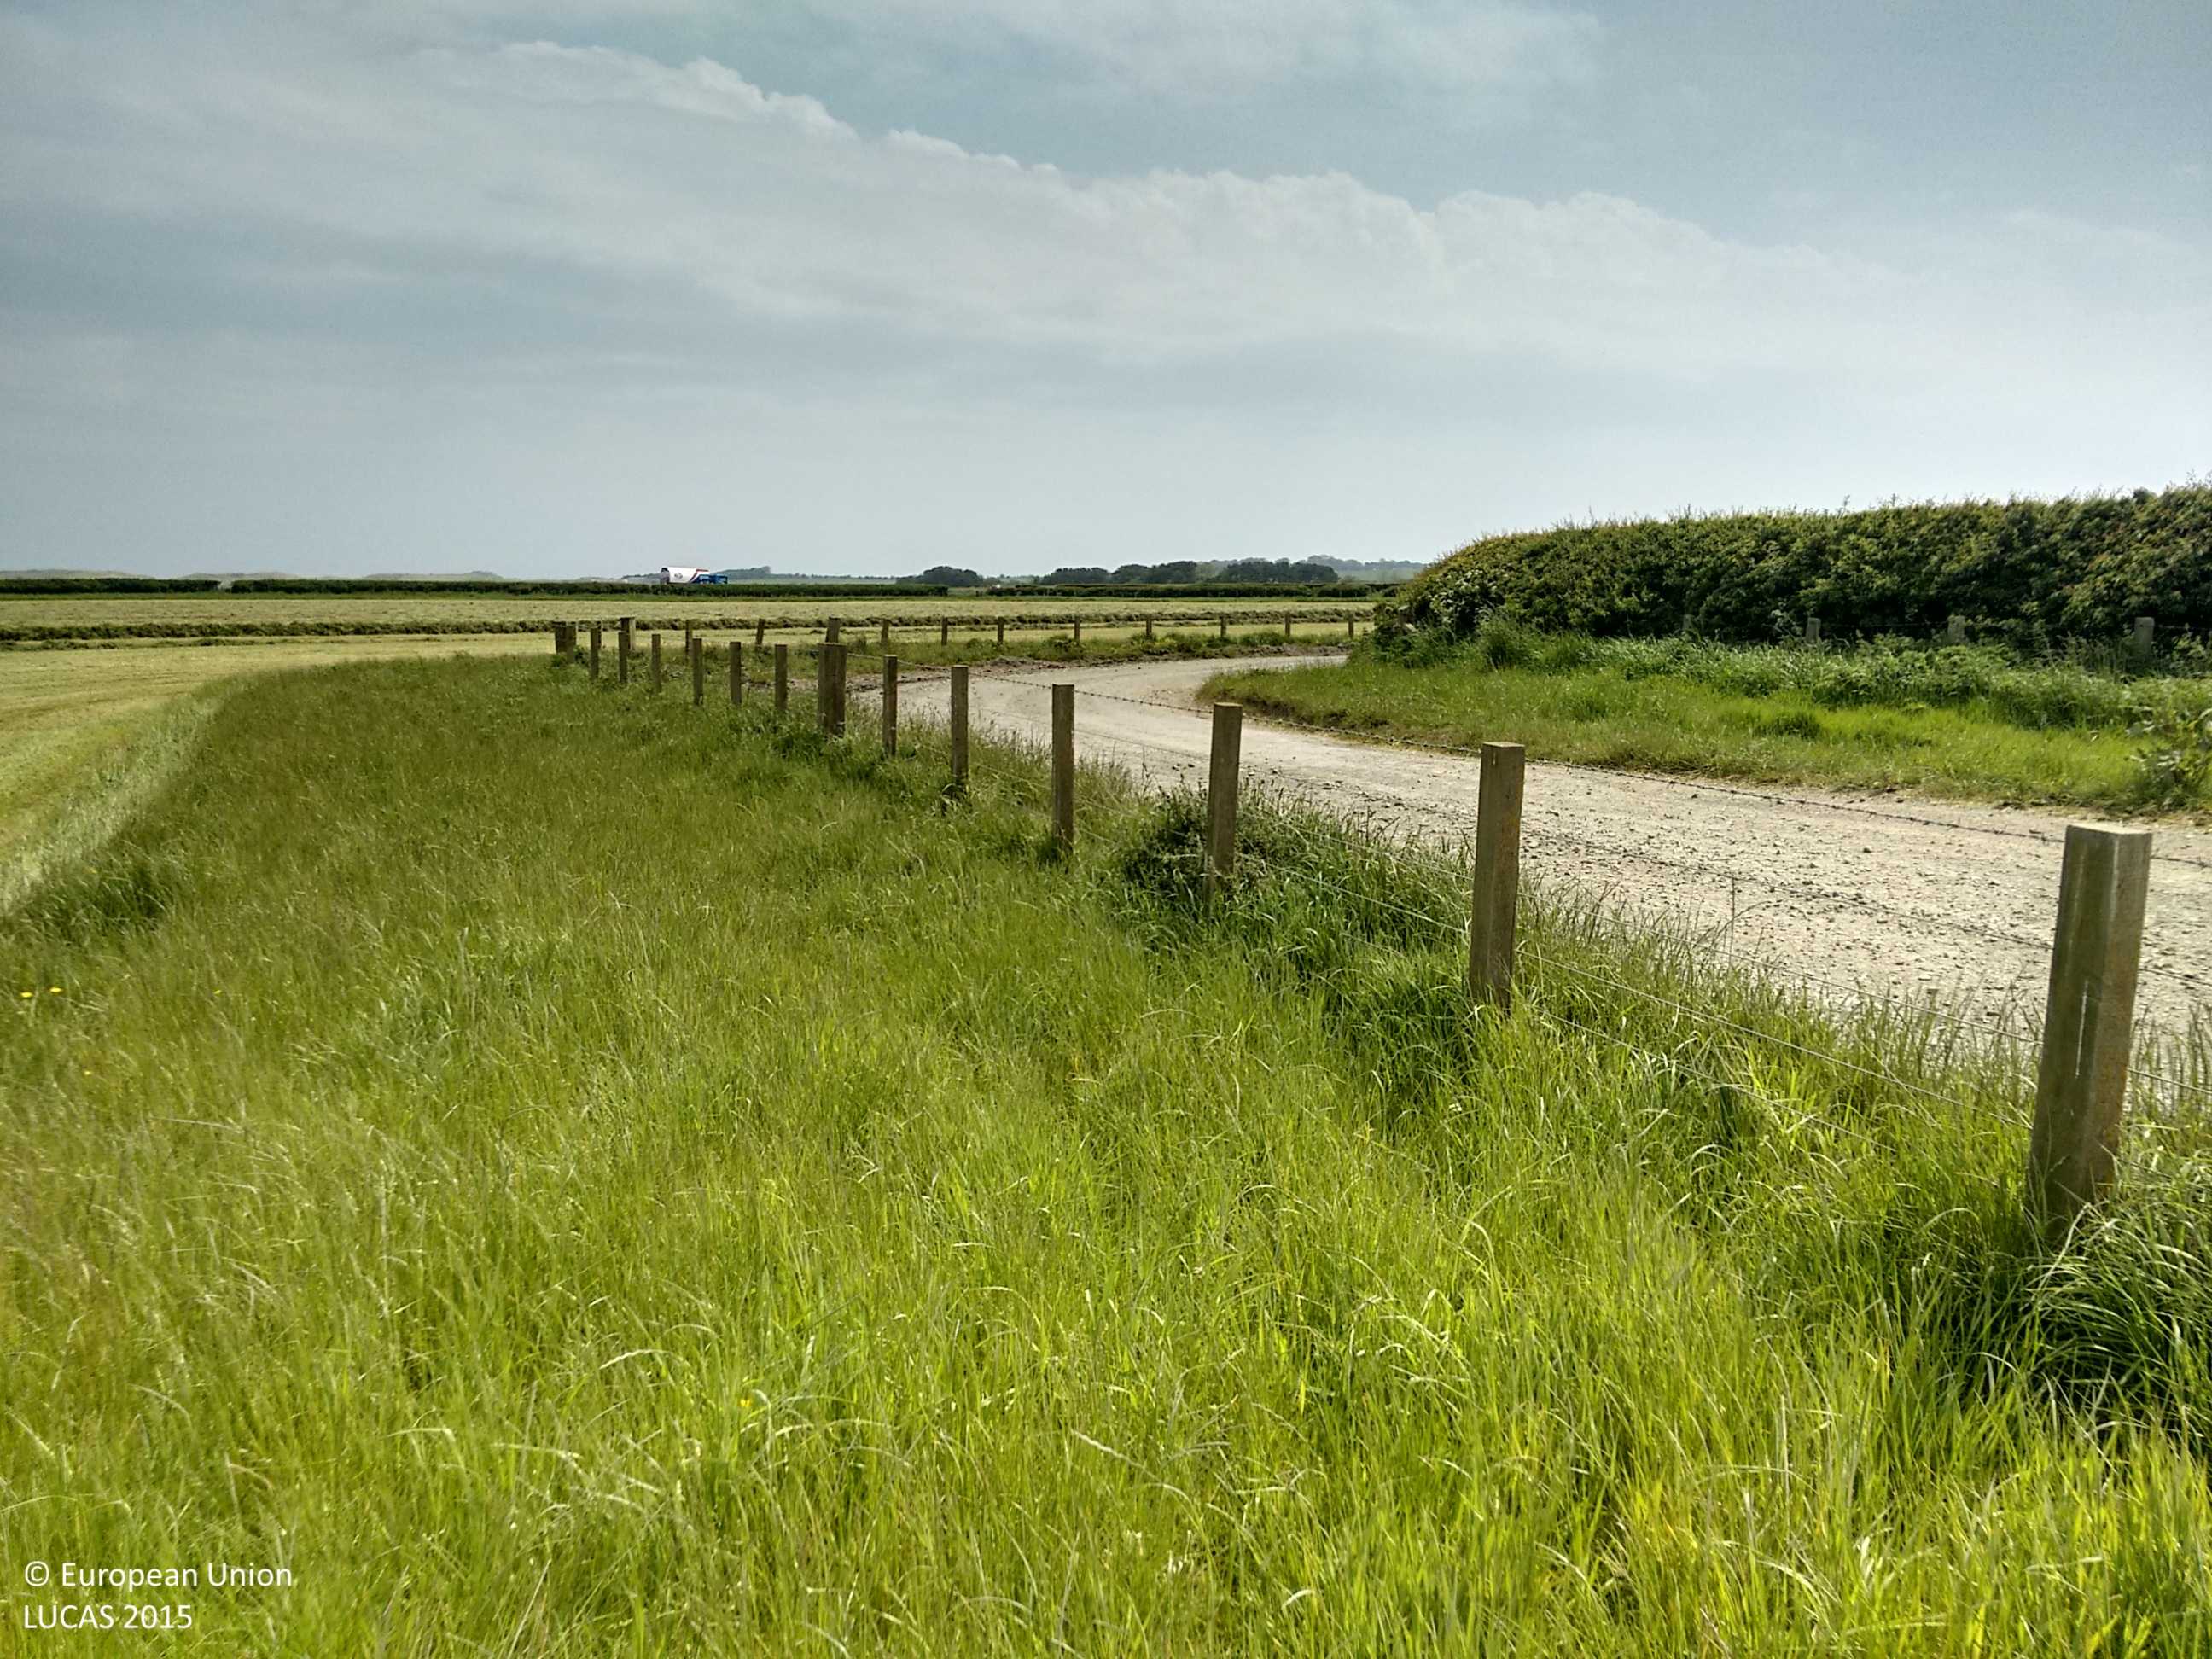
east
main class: Grassland
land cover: Grassland without tree/shrub cover
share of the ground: > 75 %
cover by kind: herbaceous plants 100 %
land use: Agriculture (excluding fallow land and kitchen gardens)
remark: Harvested field
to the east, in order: Grassland without tree/shrub cover; Fences; Grass margins; Fences; Grassland without tree/shrub cover; Managed hedges; Shruby margins; Grass margins; Paved roads, cycling and walking lanes; Grass margins; Fences; Grass margins; Grassland without tree/shrub cover
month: June
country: GB
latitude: 55.5268
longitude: -1.6598
